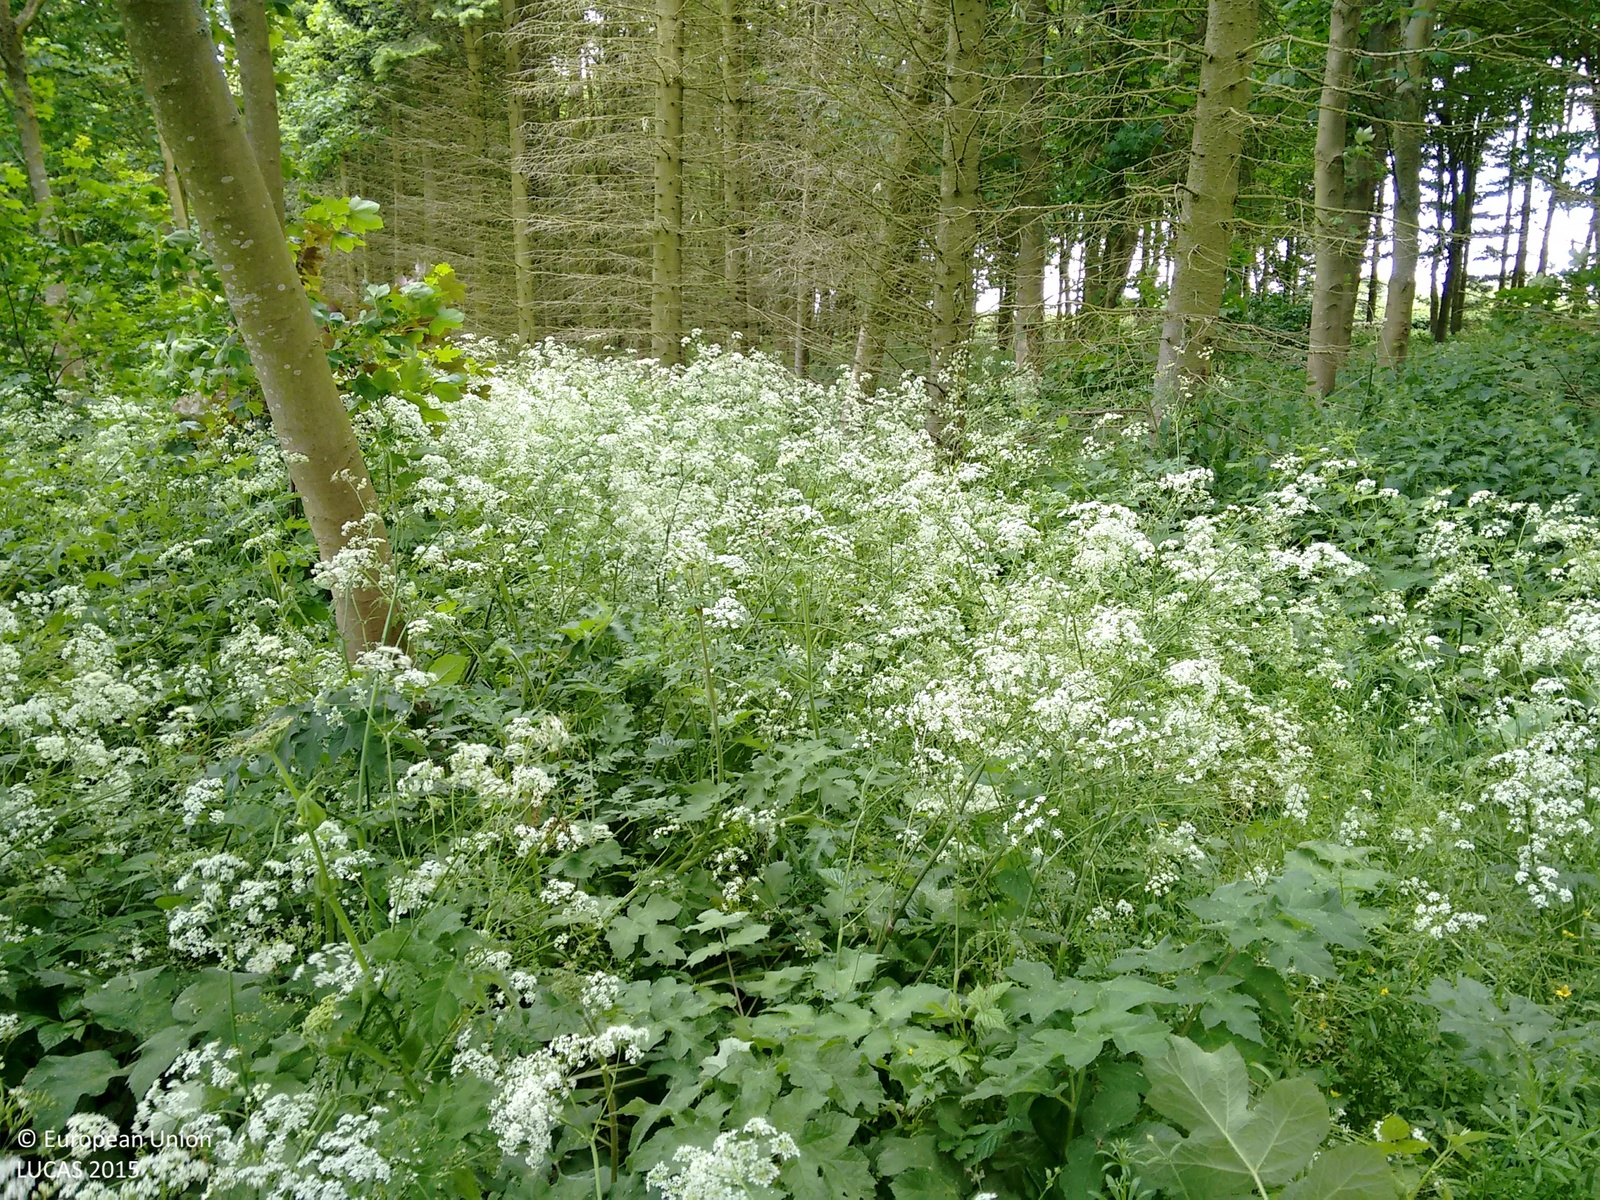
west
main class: Woodland
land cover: Broadleaved woodland
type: mesophytic deciduous forest
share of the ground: > 75 %
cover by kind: broadleaved forest trees 100 %
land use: Agriculture (excluding fallow land and kitchen gardens)
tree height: > 5 m
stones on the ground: < 10 %
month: June
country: GB
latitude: 52.8017
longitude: -0.6750
